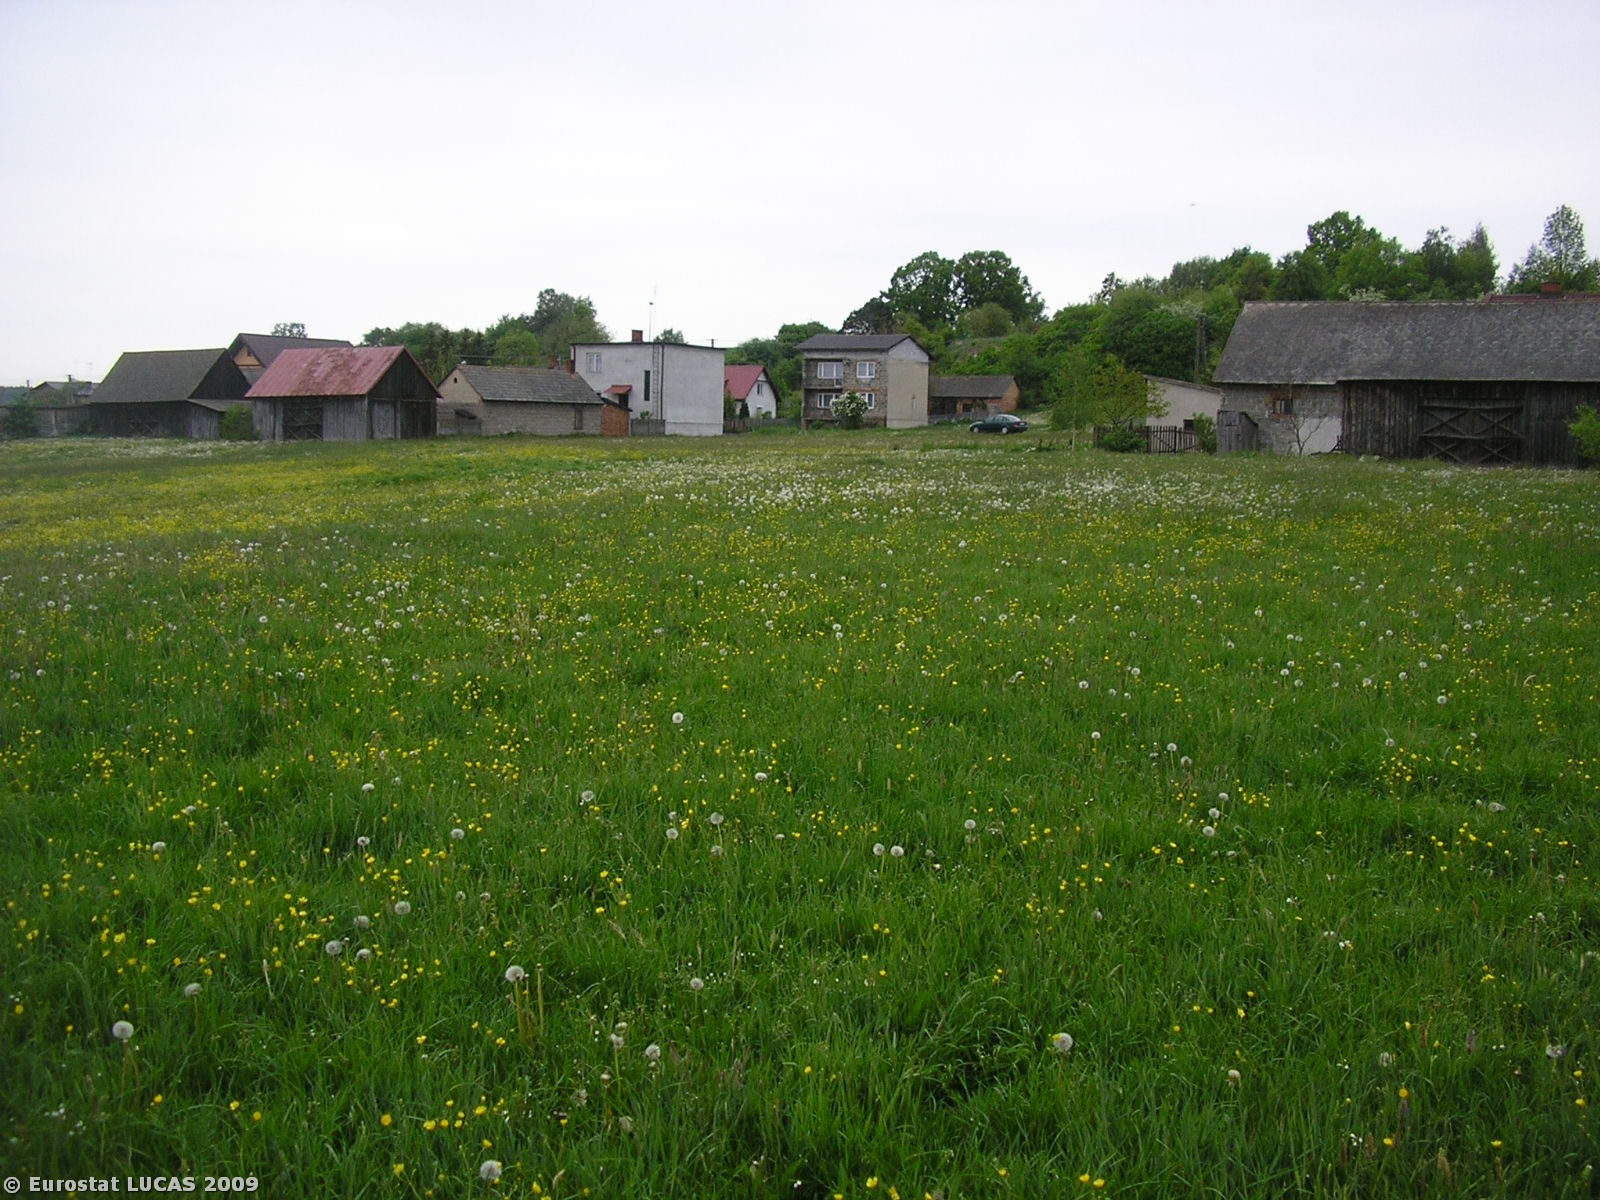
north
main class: Grassland
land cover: Grassland without tree/shrub cover
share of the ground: > 75 %
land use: Agriculture (excluding fallow land and kitchen gardens)
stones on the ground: < 10 %
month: May
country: PL
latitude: 51.4821
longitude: 20.0121
